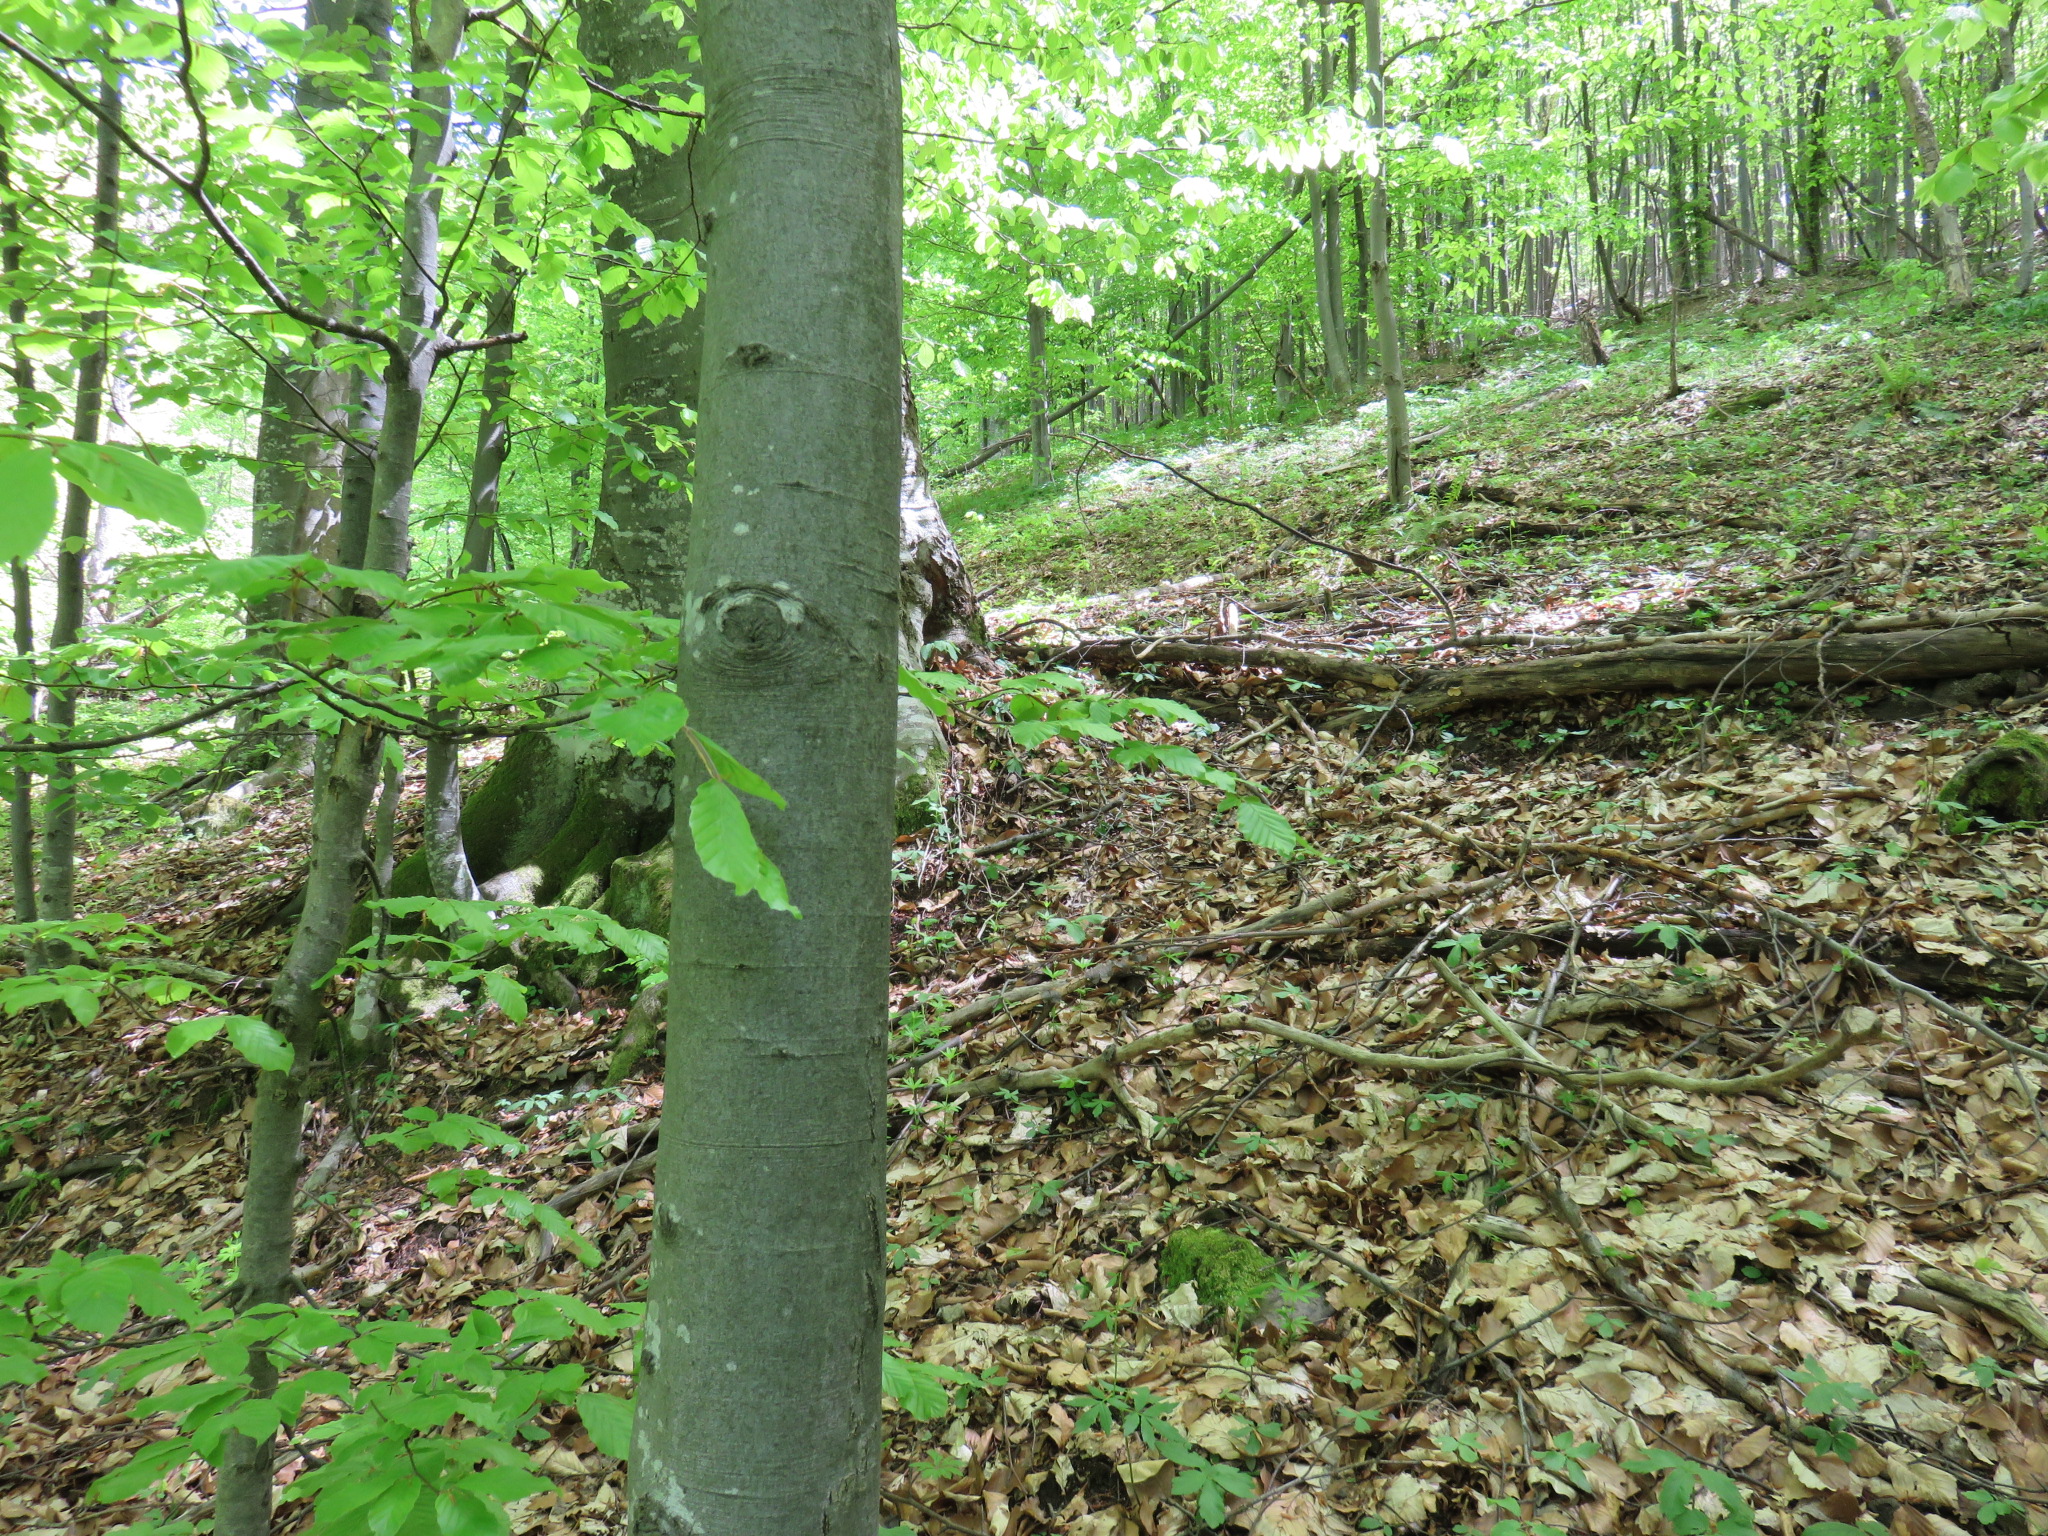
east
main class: Woodland
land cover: Broadleaved woodland
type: beech forest
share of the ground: > 75 %
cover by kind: broadleaved forest trees 85 %, unconsolidated bare surface 15 %
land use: Forestry
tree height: > 5 m
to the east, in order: Broadleaved woodland; Tracks; Broadleaved woodland; Rivers and streams; Broadleaved woodland; Shrubland with sparse tree cover; Broadleaved woodland; Tracks; Broadleaved woodland; Tracks; Rivers and streams; Grassland with sparse tree/shrub cover
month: May
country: BG
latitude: 42.8386
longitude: 24.8281
